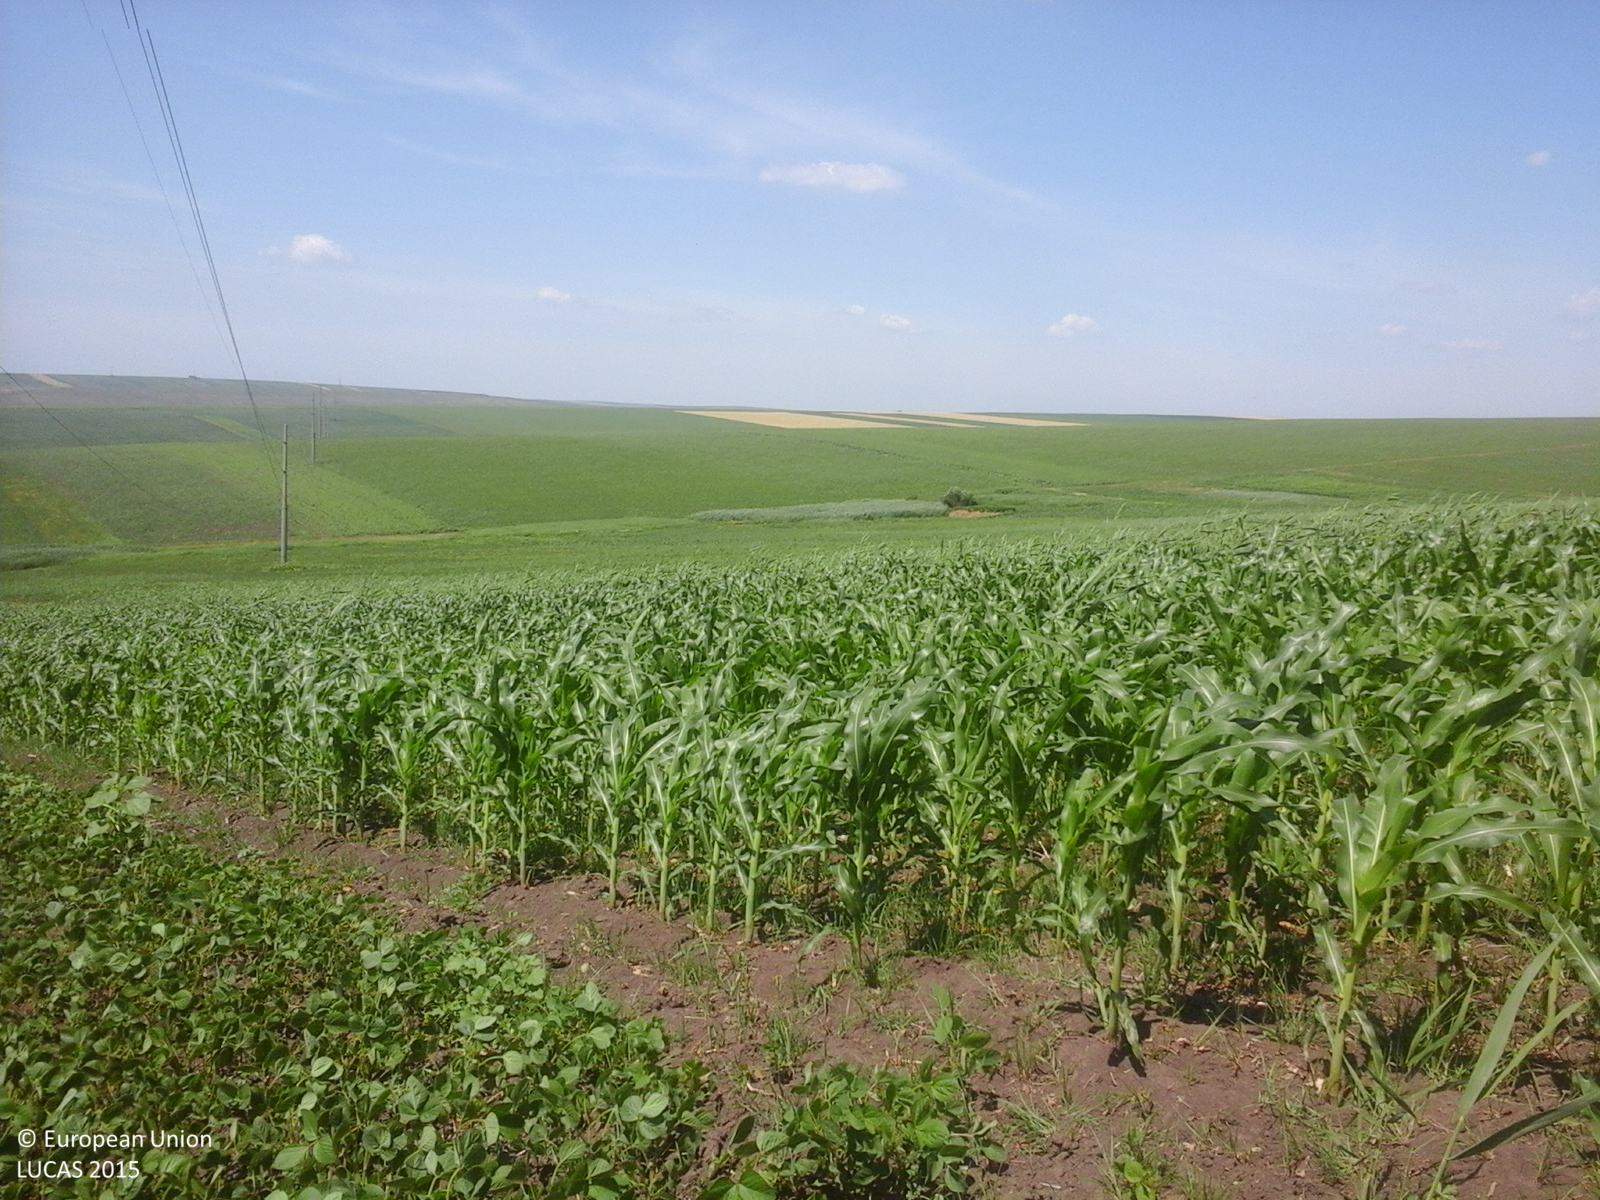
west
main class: Cropland
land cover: Soya
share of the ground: > 75 %
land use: Agriculture (excluding fallow land and kitchen gardens)
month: June
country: RO
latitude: 47.7841
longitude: 27.0439
